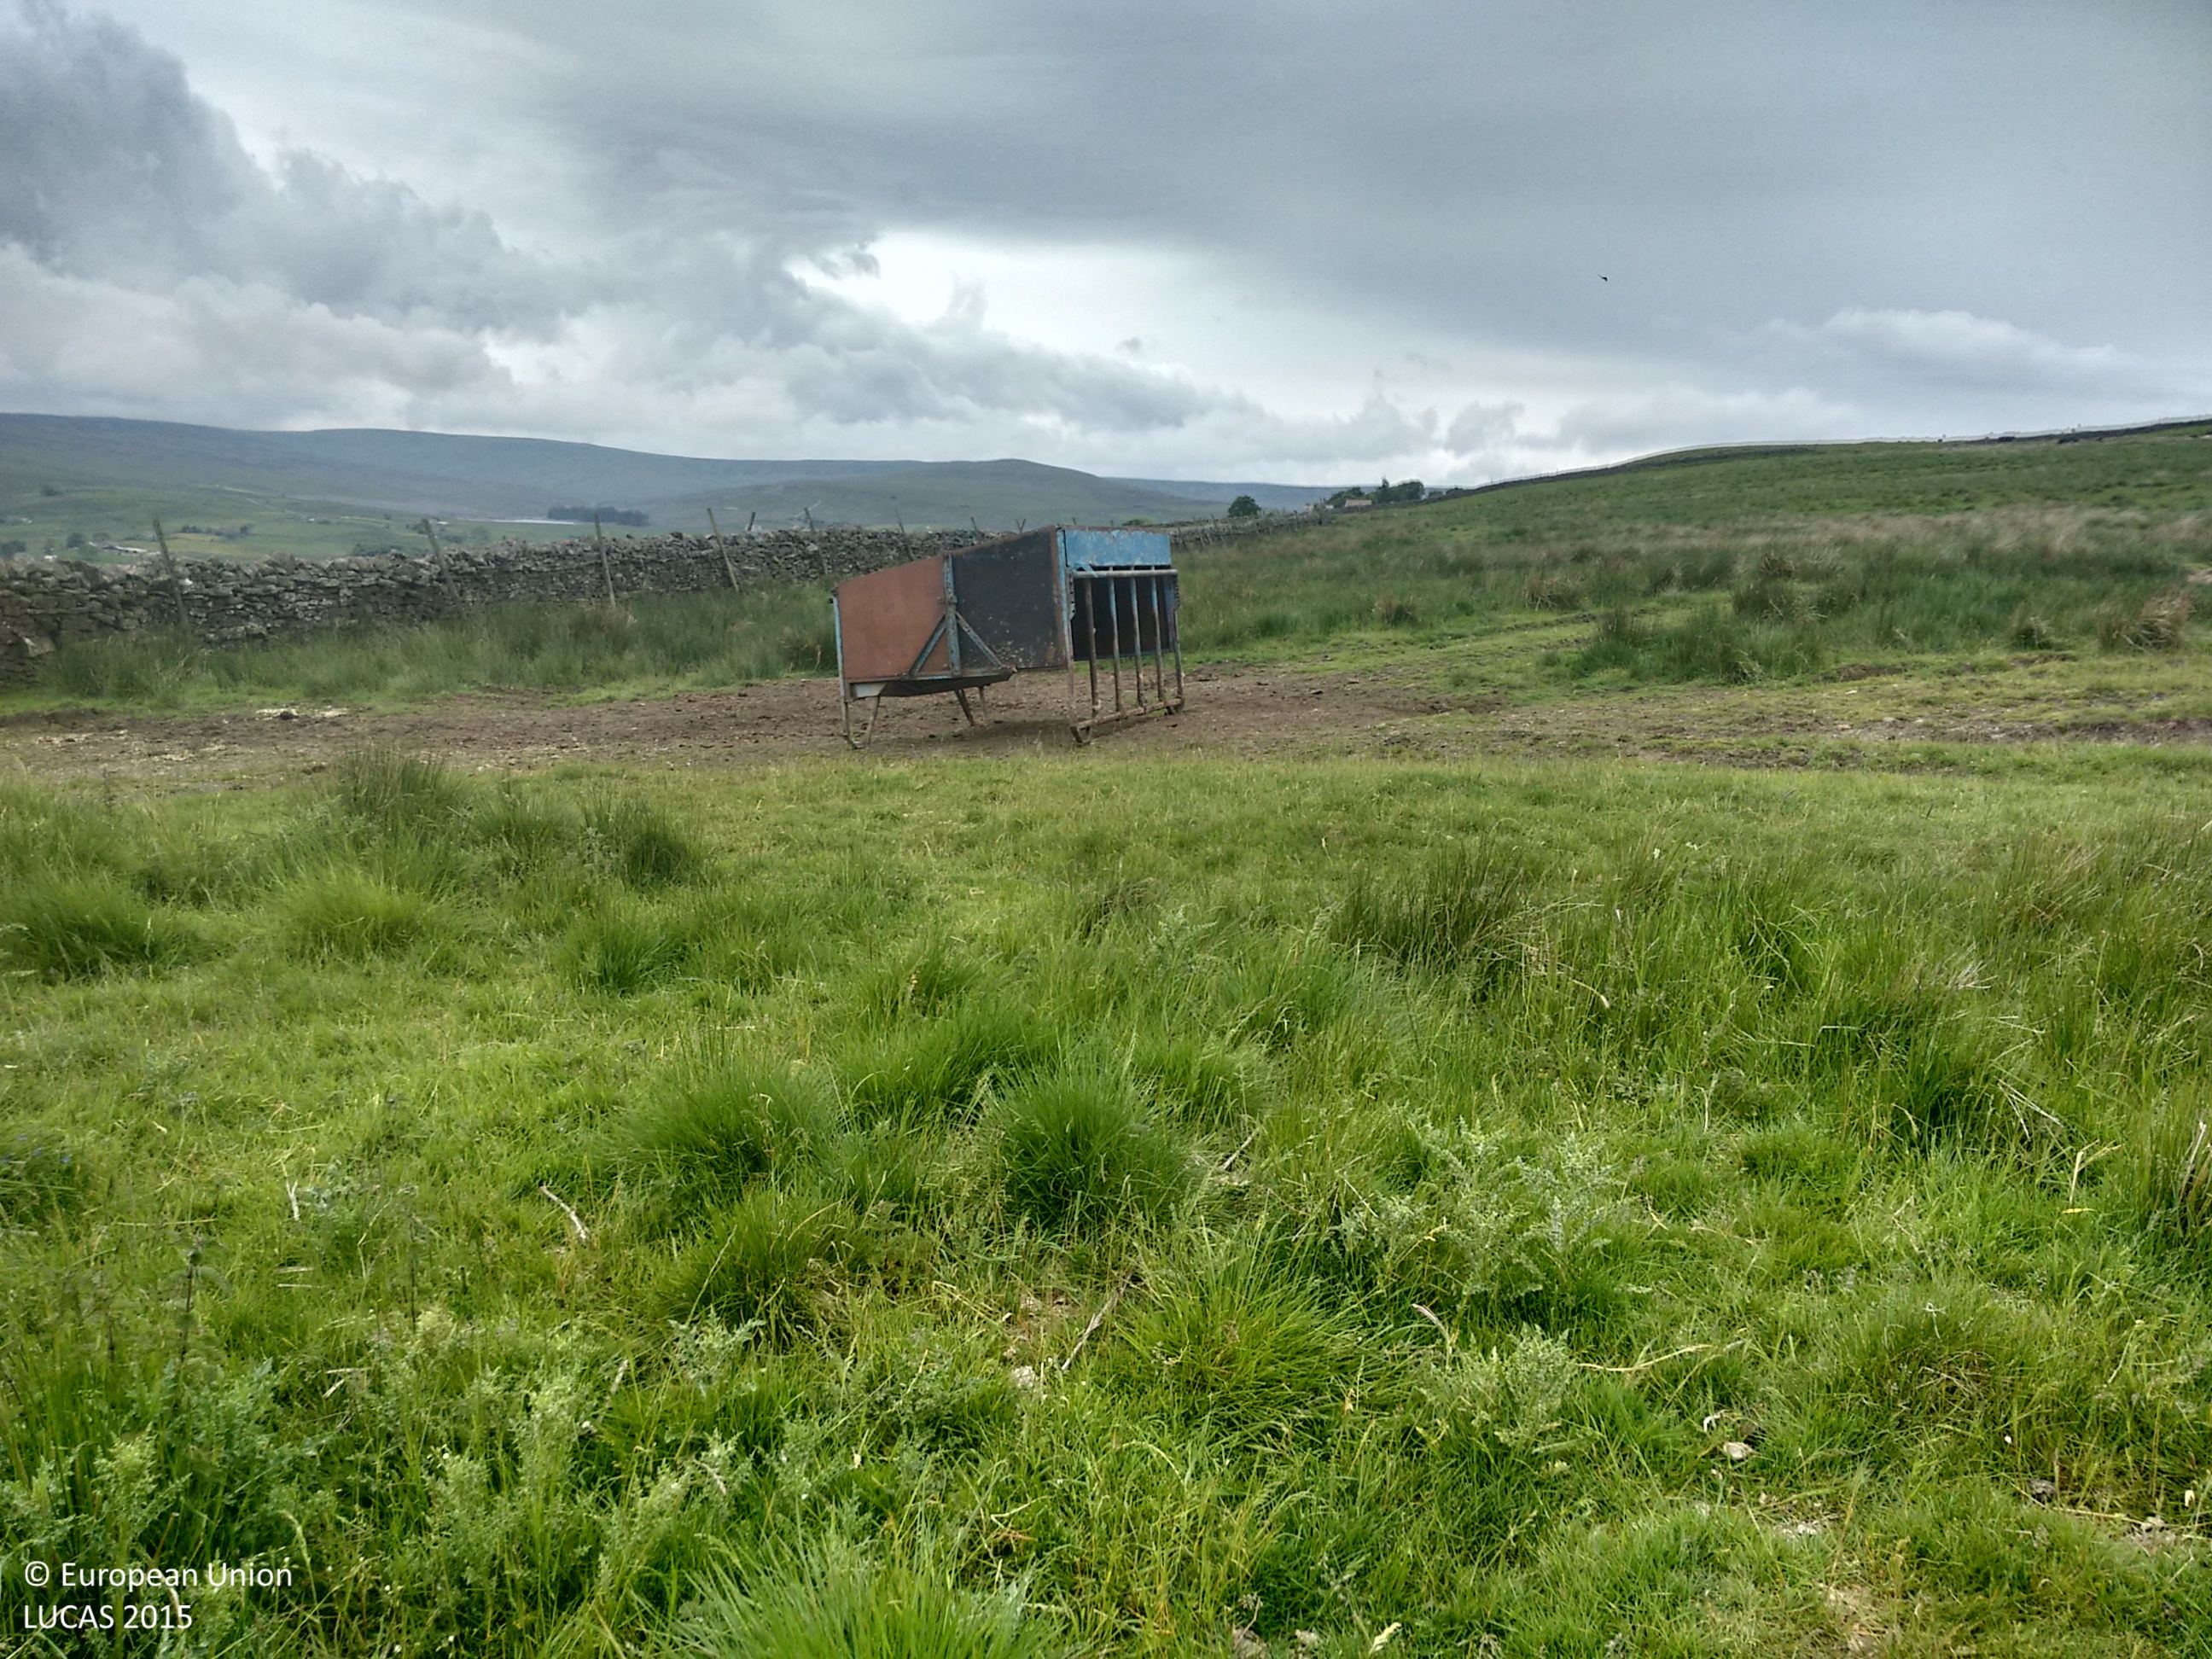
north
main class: Grassland
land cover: Grassland without tree/shrub cover
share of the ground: > 75 %
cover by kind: herbaceous plants 100 %
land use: Agriculture (excluding fallow land and kitchen gardens)
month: June
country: GB
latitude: 54.7482
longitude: -2.1916
